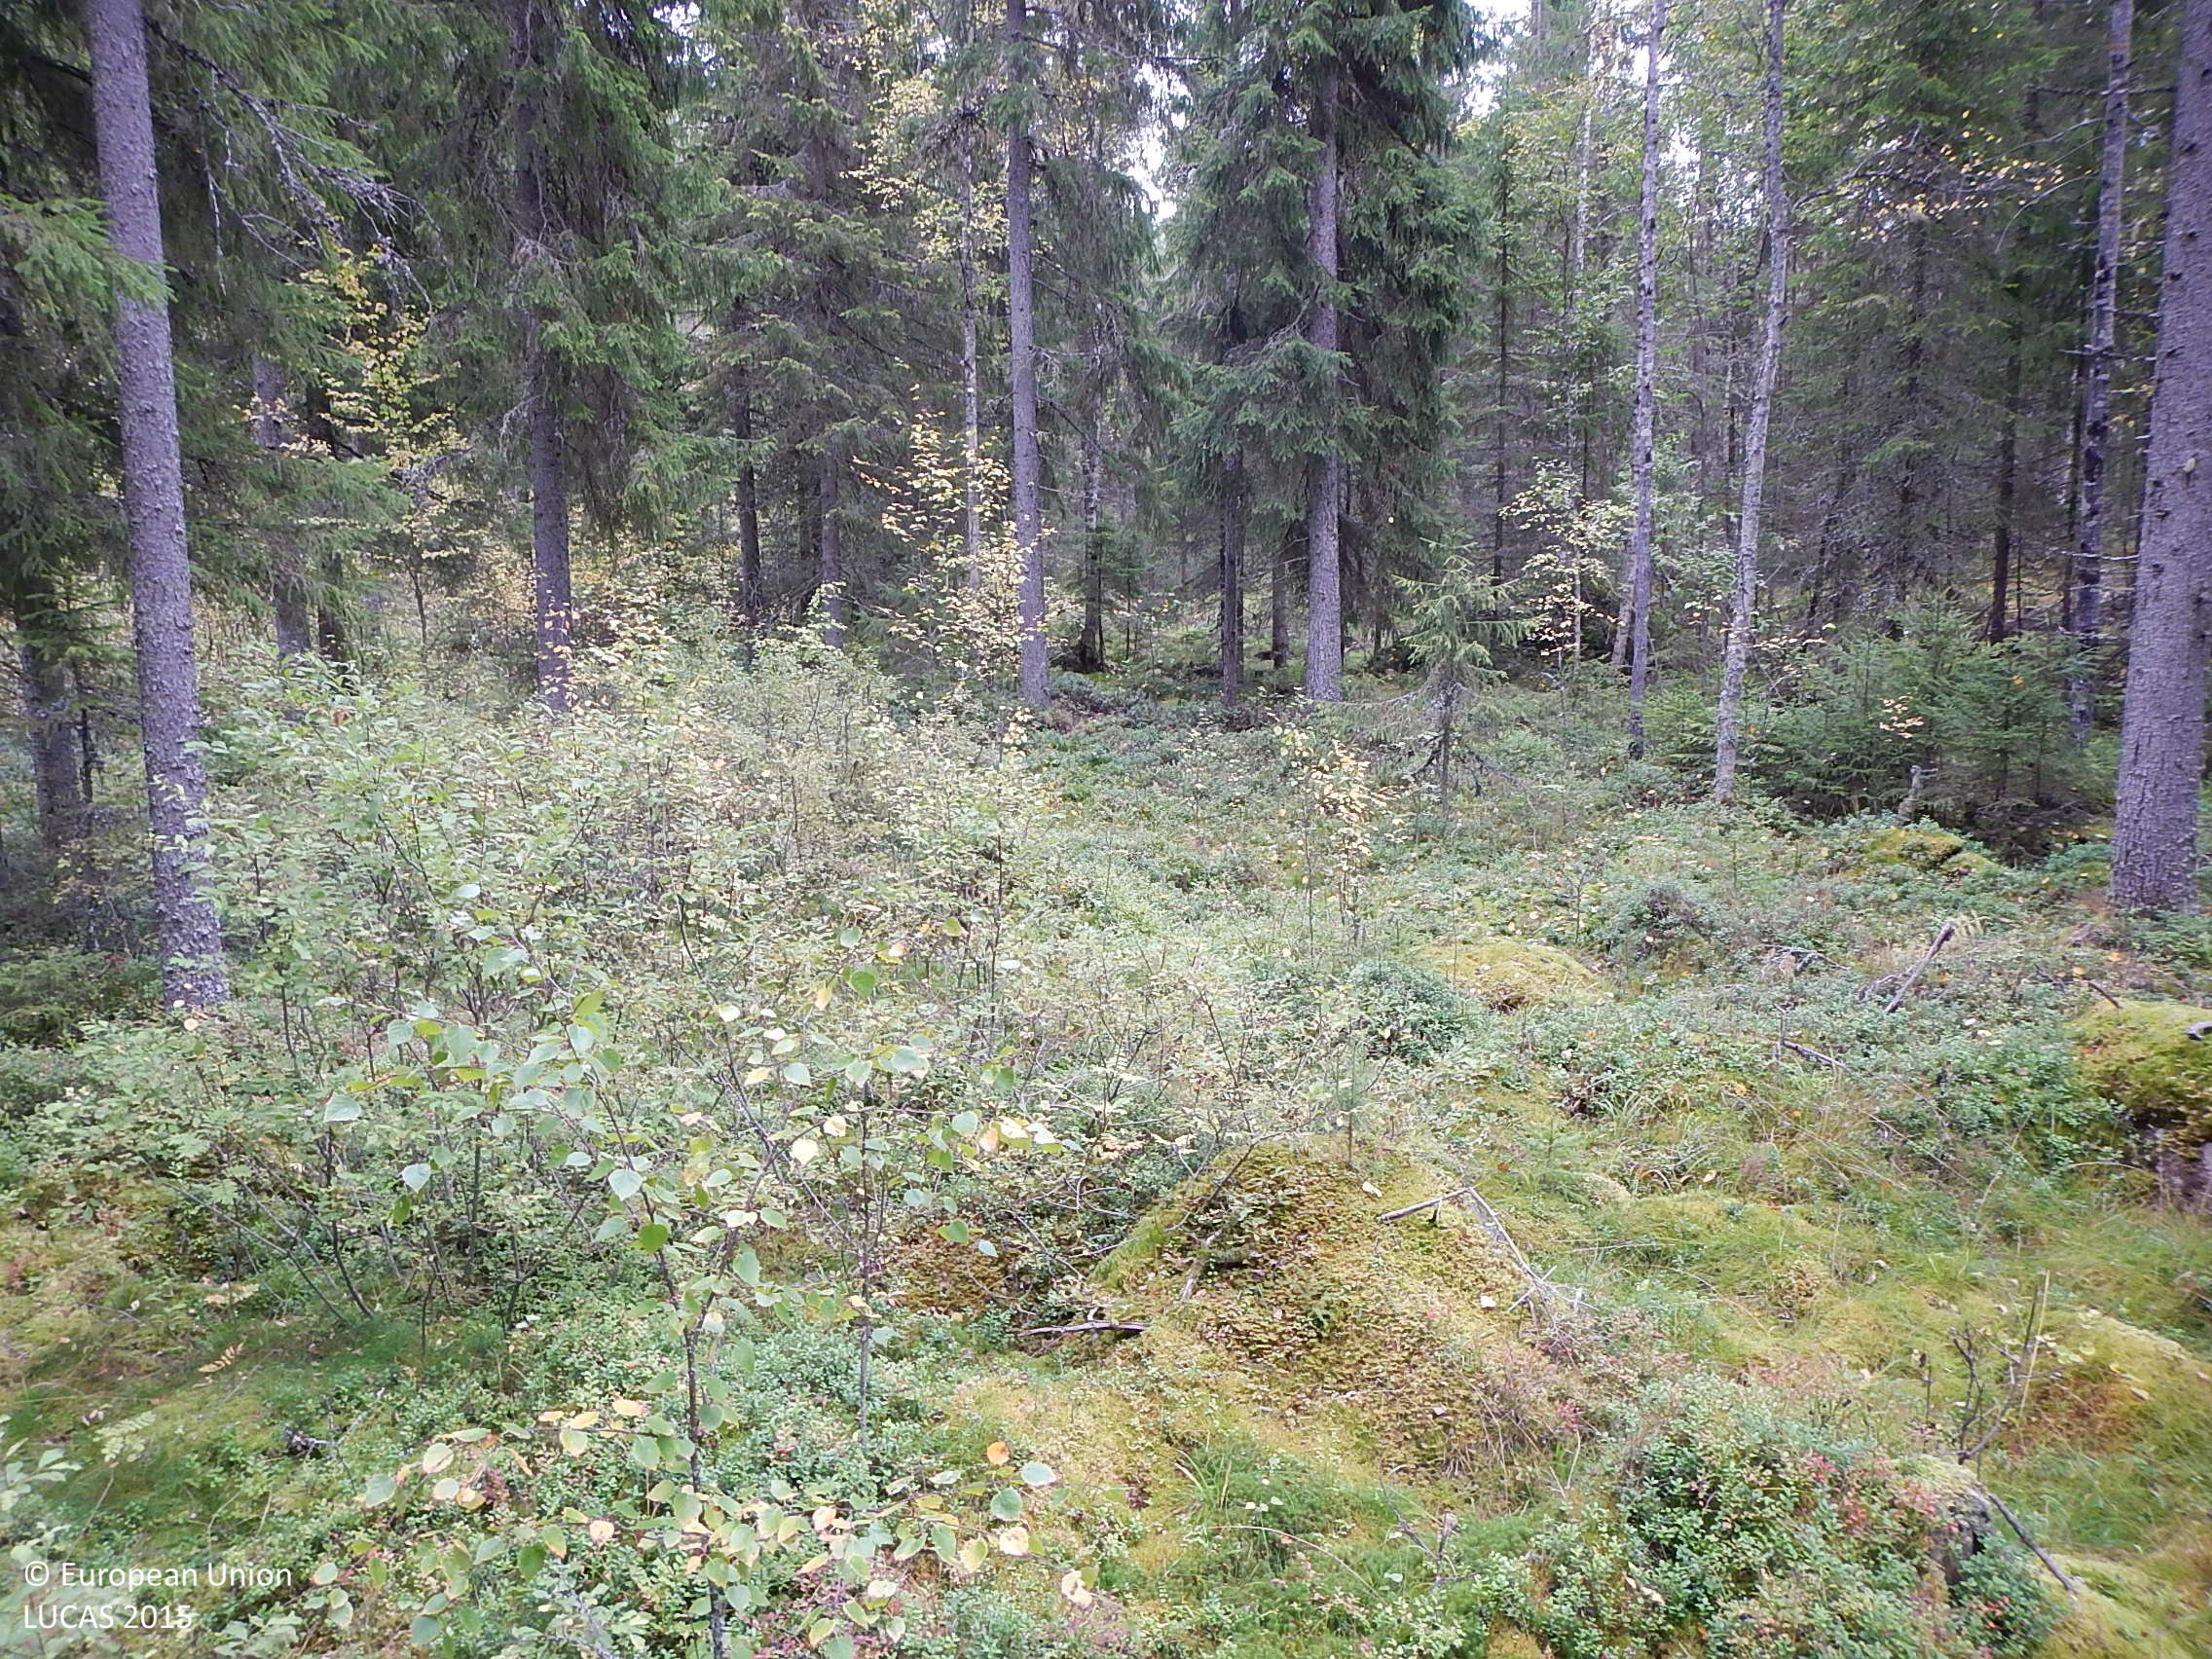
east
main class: Woodland
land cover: Spruce dominated coniferous woodland
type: boreal forest
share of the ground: 50 - 75 %
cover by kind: coniferous forest trees 40 %, shrubs 40 %, broadleaved forest trees 10 %, lichens and mosses 10 %
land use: Forestry
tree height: > 5 m
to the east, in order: Spruce dominated coniferous woodland; Ditches and canals; Spruce dominated coniferous woodland; Pine dominated coniferous woodland; Other coniferous woodland; Spruce dominated coniferous woodland; Other mixed woodland; Spruce dominated mixed woodland
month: September
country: FI
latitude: 61.8426
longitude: 22.8117
